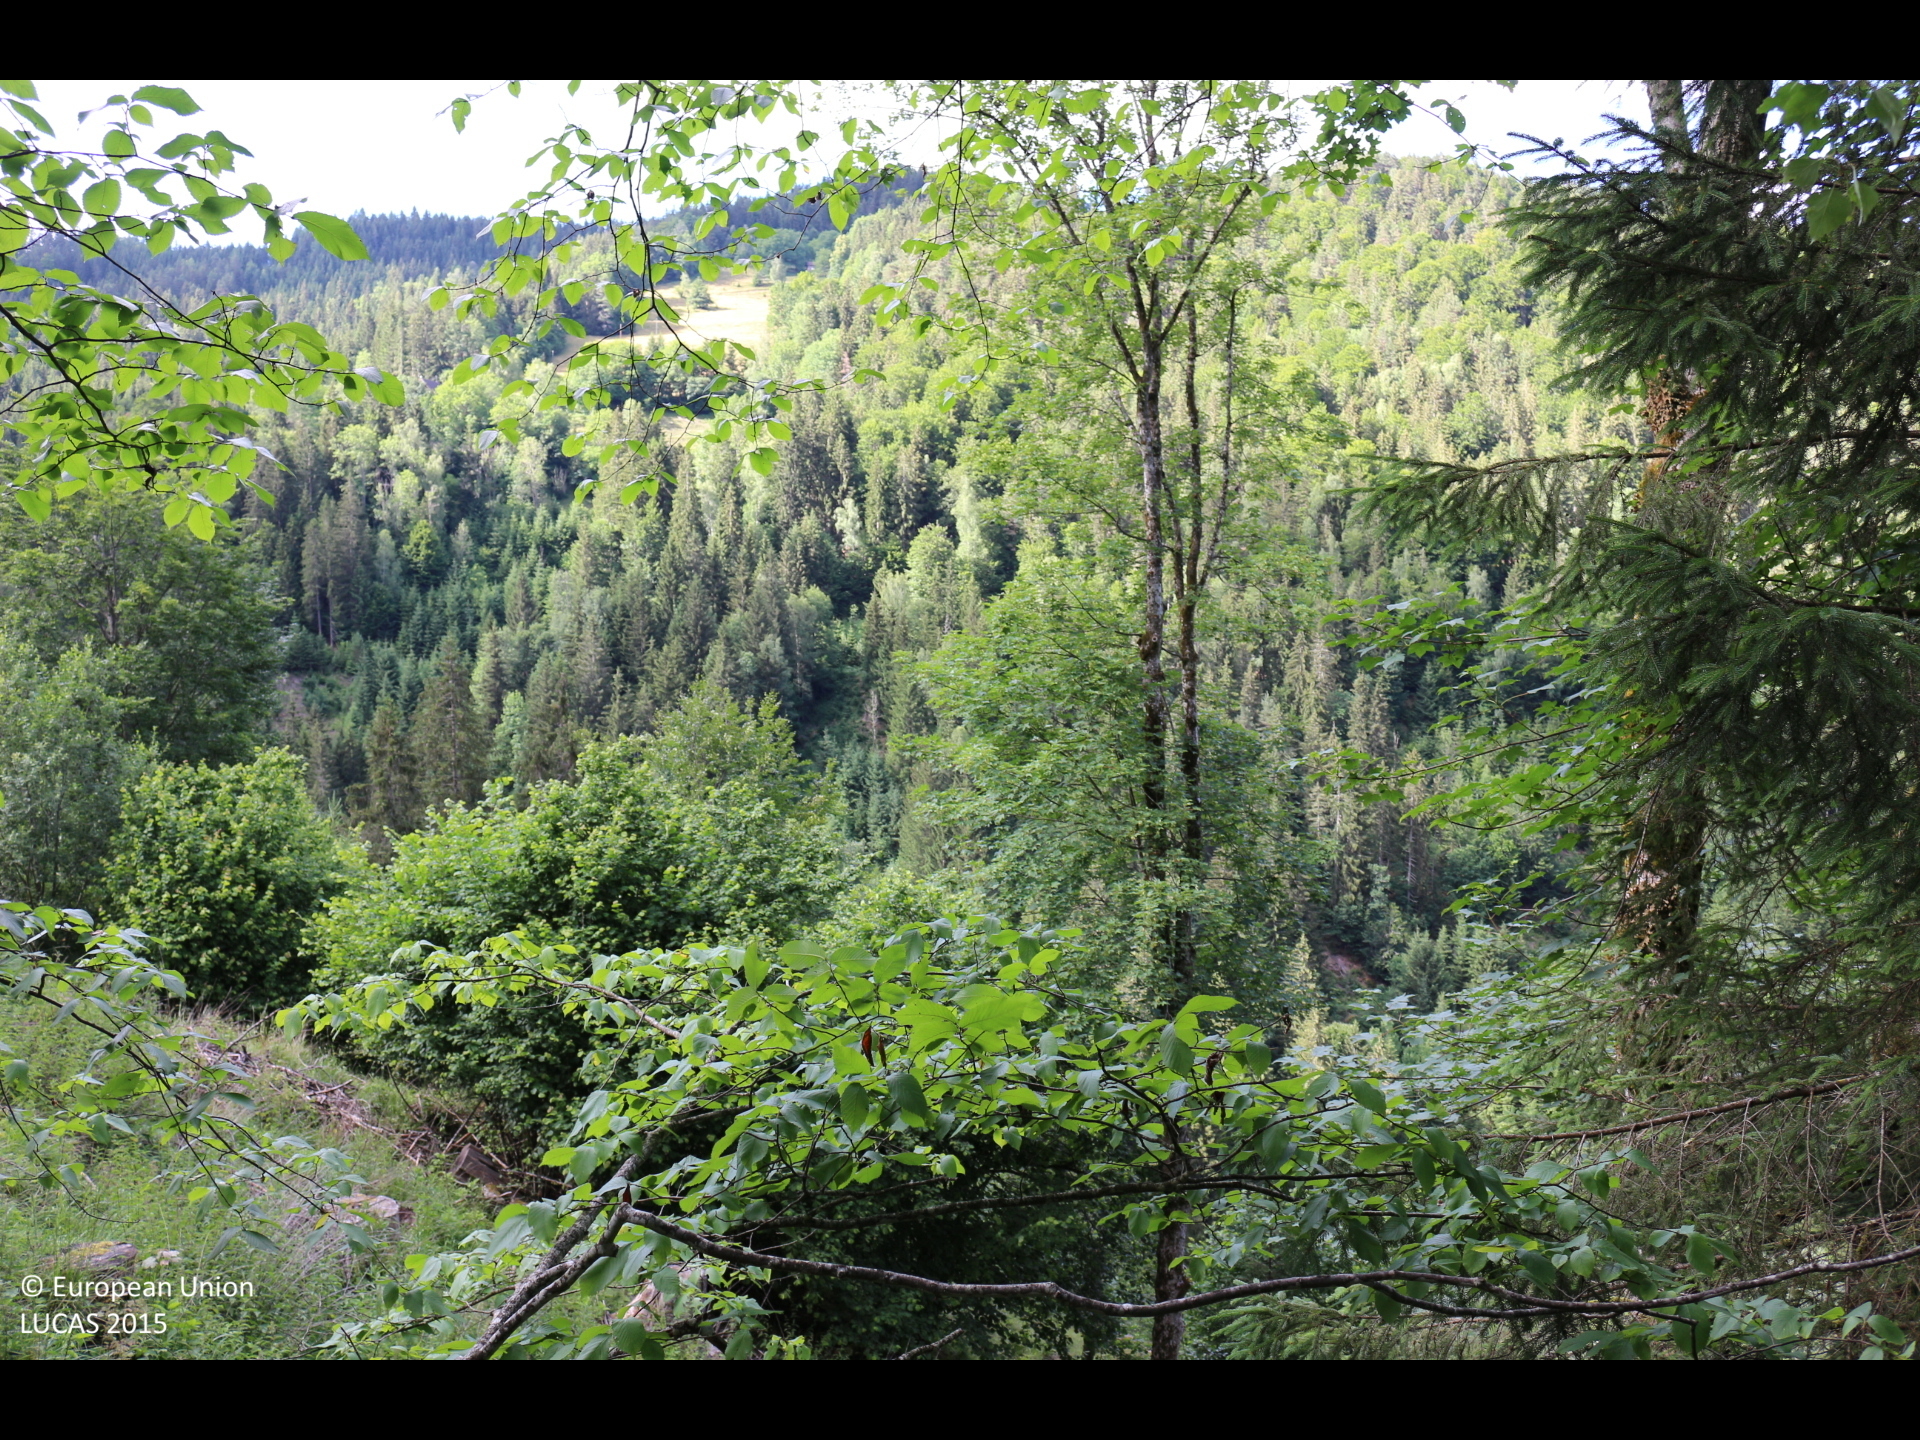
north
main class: Woodland
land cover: Broadleaved woodland
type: mountainous beech forest
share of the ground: > 75 %
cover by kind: broadleaved forest trees 90 %, coniferous forest trees 10 %
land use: Forestry
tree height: > 5 m
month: June
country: AT
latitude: 46.8404
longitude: 14.3380
